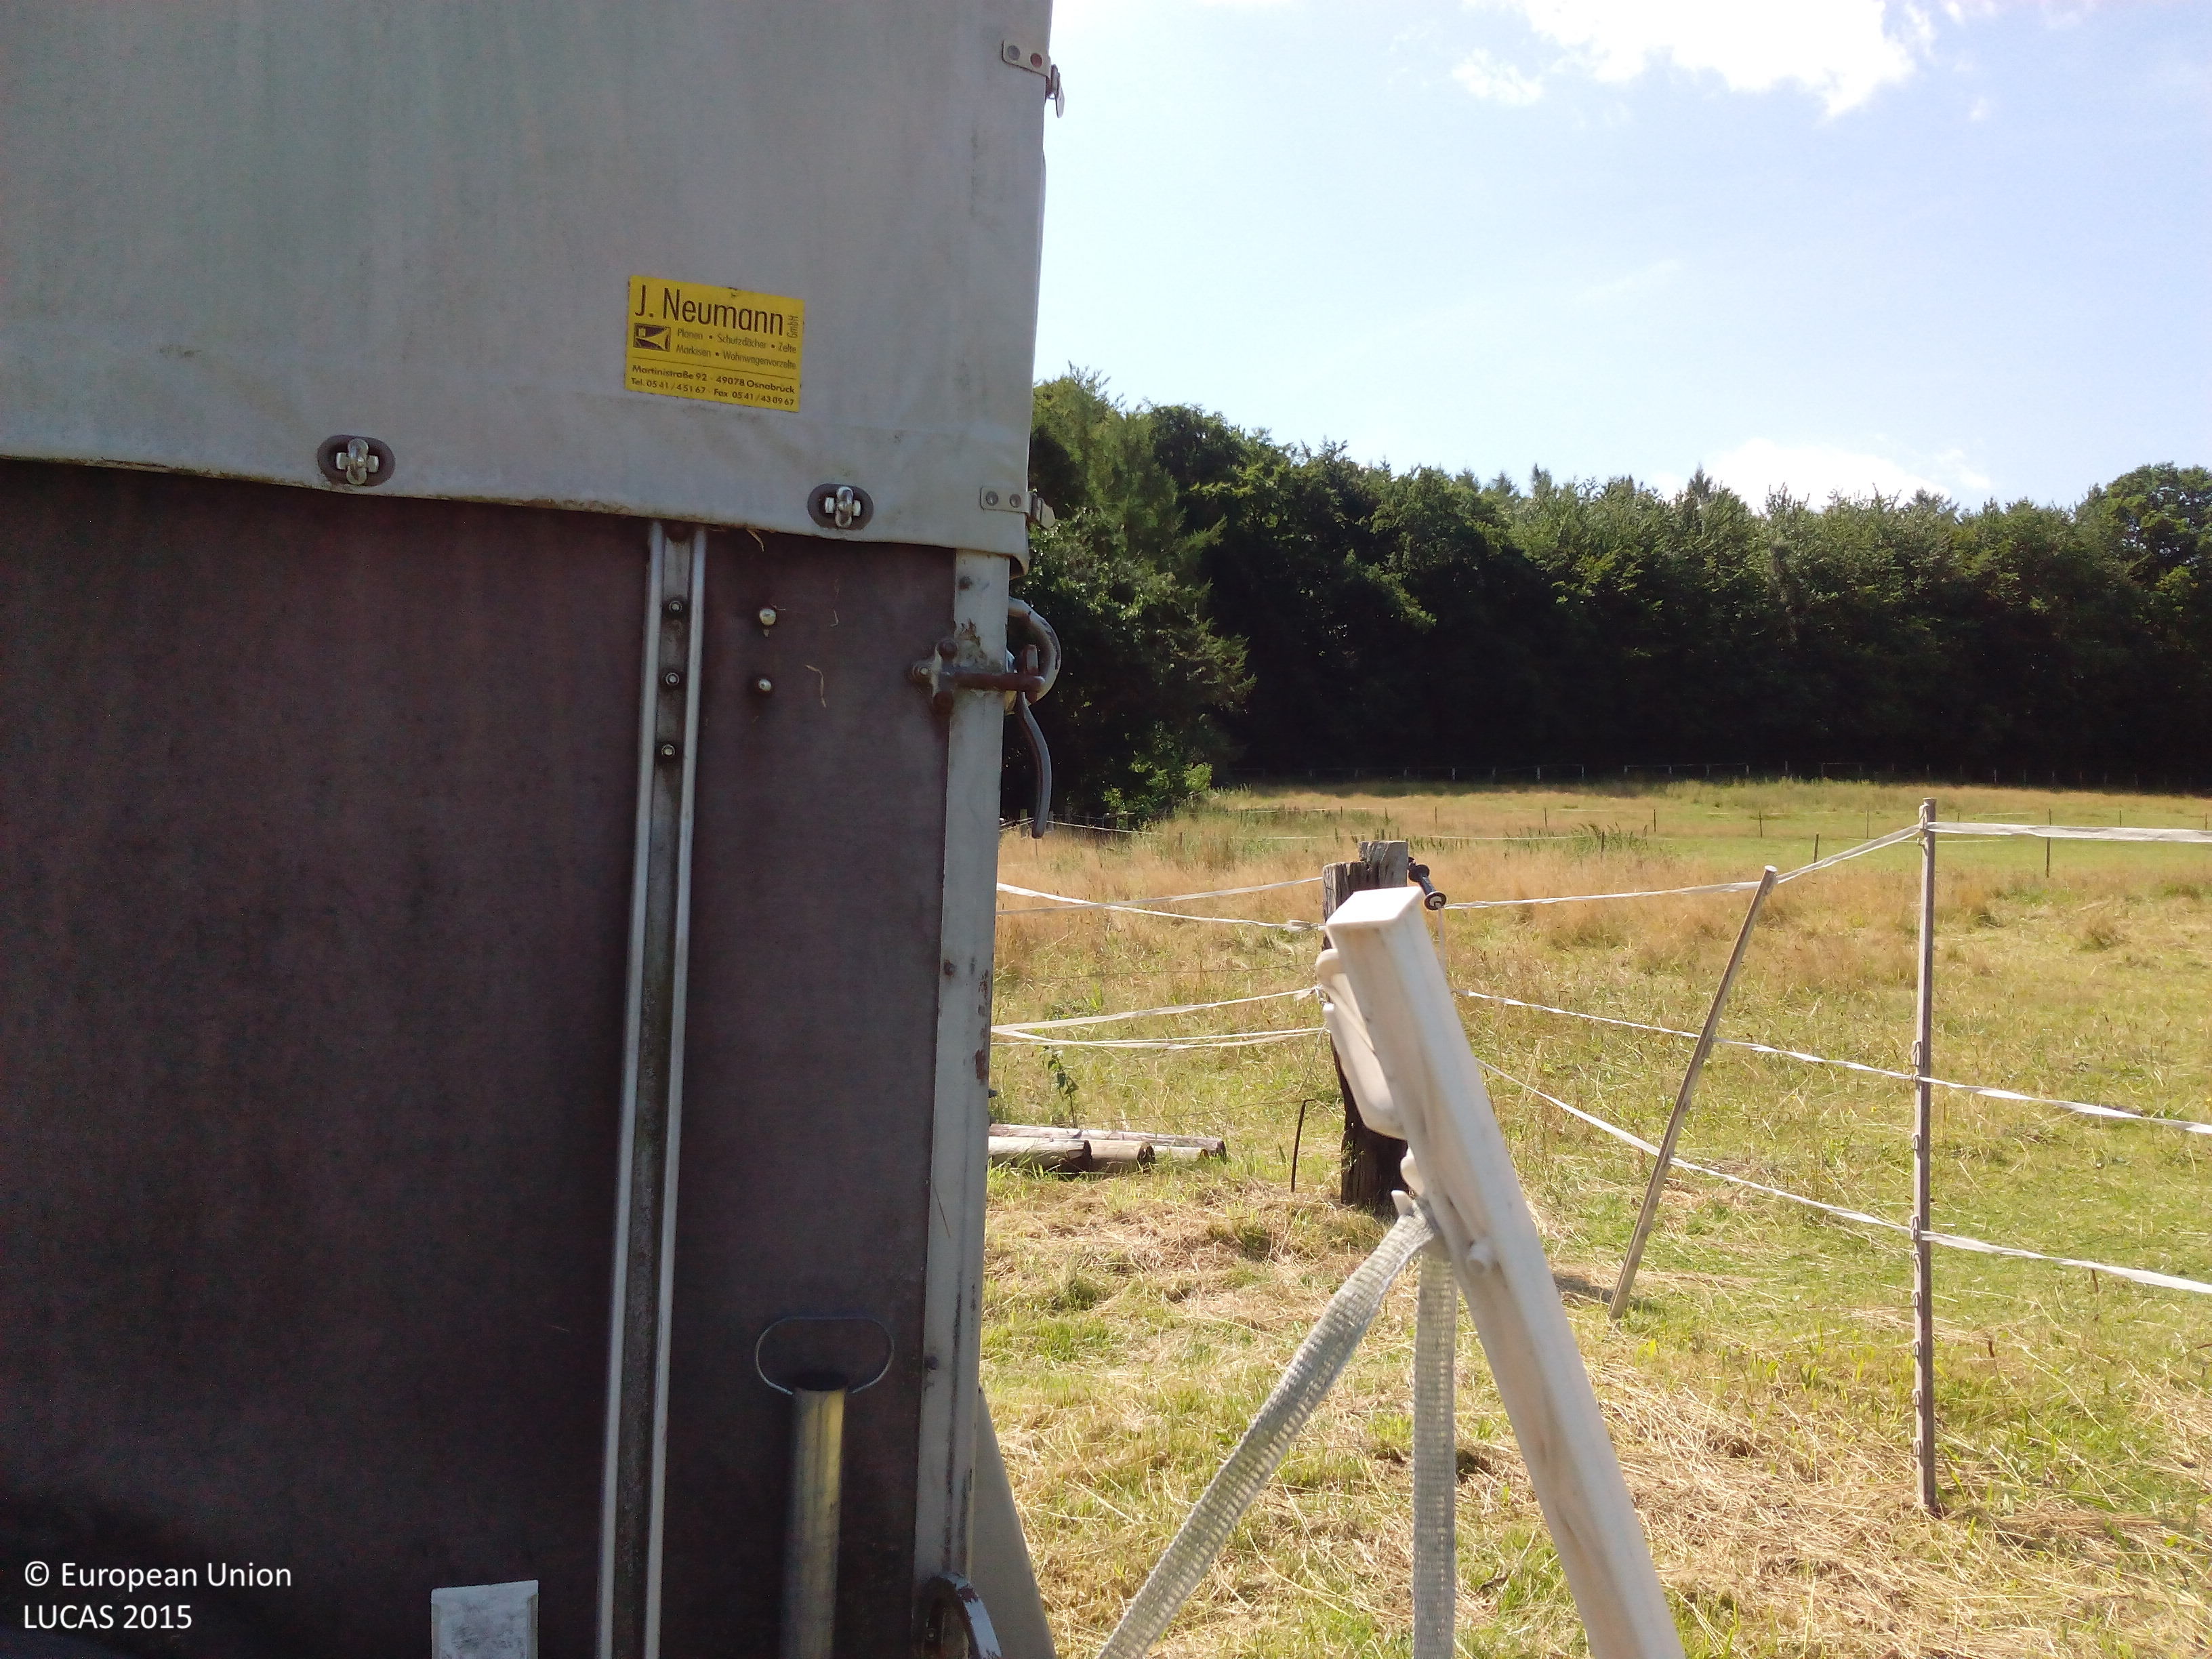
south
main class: Grassland
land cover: Grassland without tree/shrub cover
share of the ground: > 75 %
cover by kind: herbaceous plants 100 %
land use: Residential
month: July
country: DE
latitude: 52.2342
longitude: 7.9651
